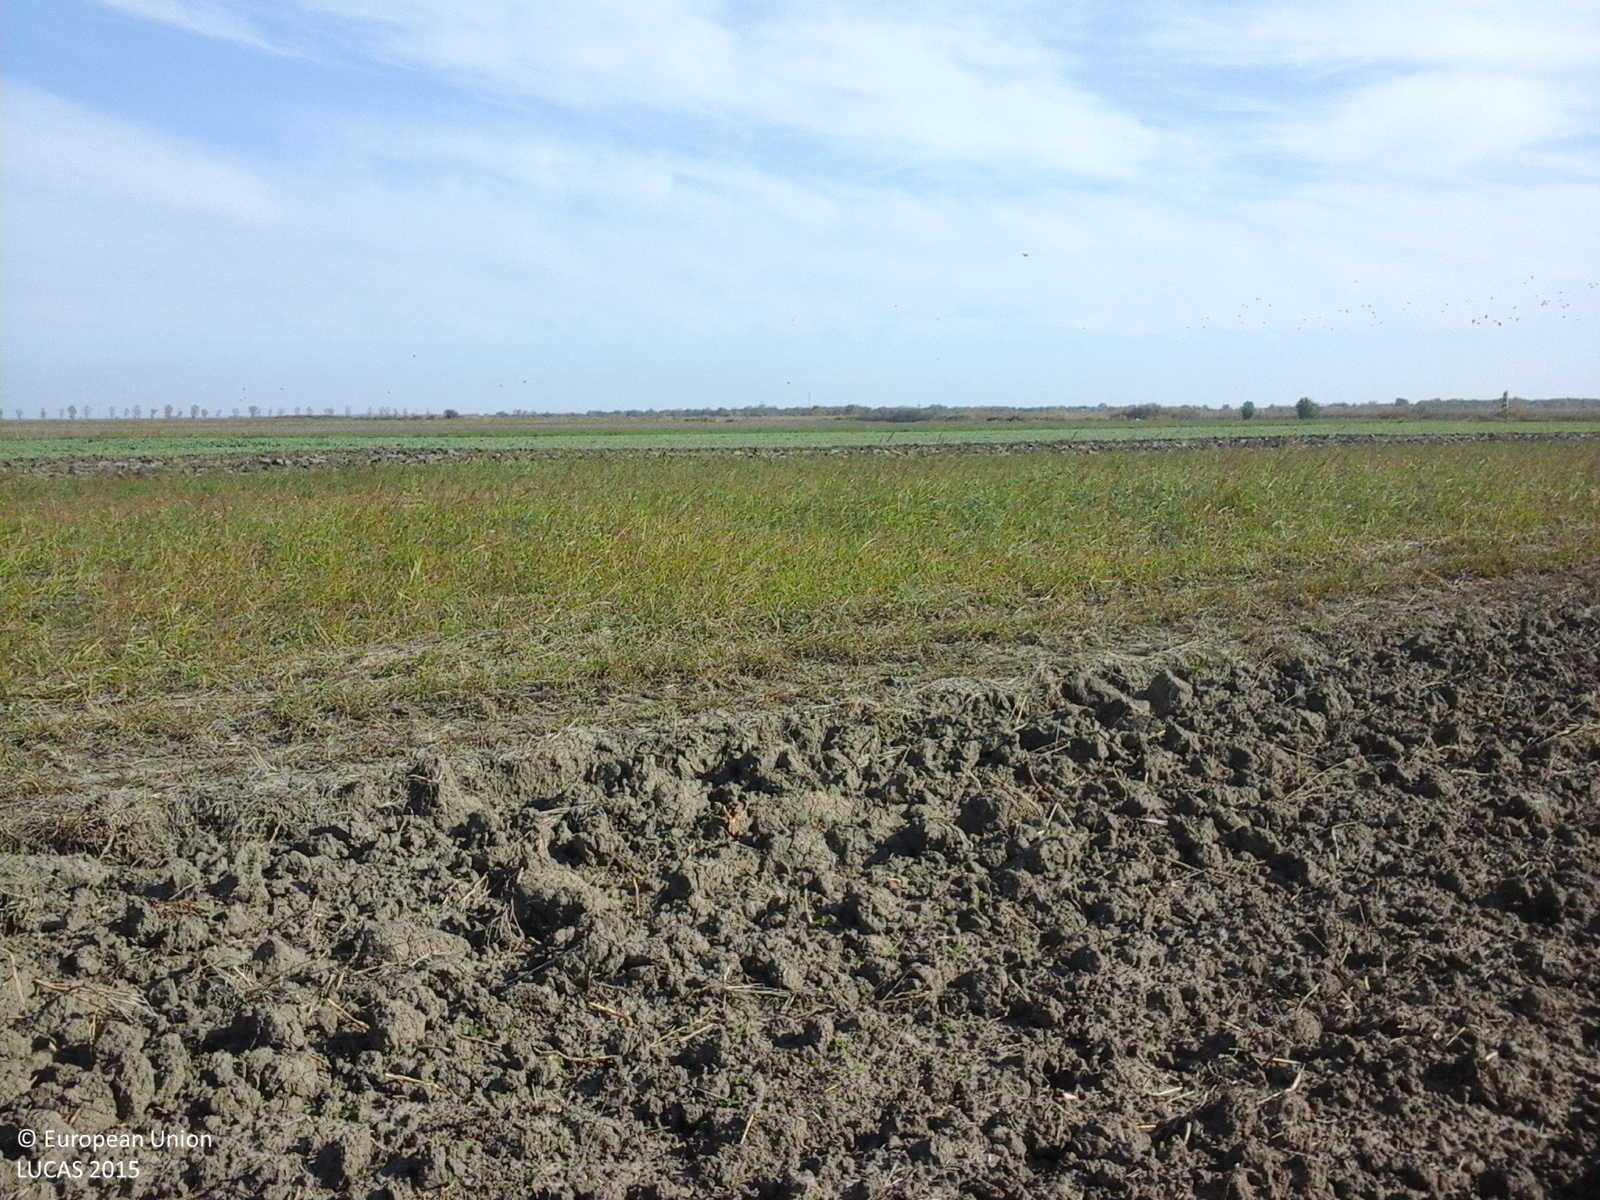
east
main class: Cropland
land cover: Maize
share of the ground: < 10 %
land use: Agriculture (excluding fallow land and kitchen gardens)
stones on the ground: < 10 %
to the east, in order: Maize; Grassland without tree/shrub cover; Maize; Rape and turnip rape; Common wheat; Other bare soil; Tracks; Spontaneously vegetated surfaces; Ditches and canals; Spontaneously vegetated surfaces; Maize
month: October
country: RO
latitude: 45.4934
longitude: 27.4393
